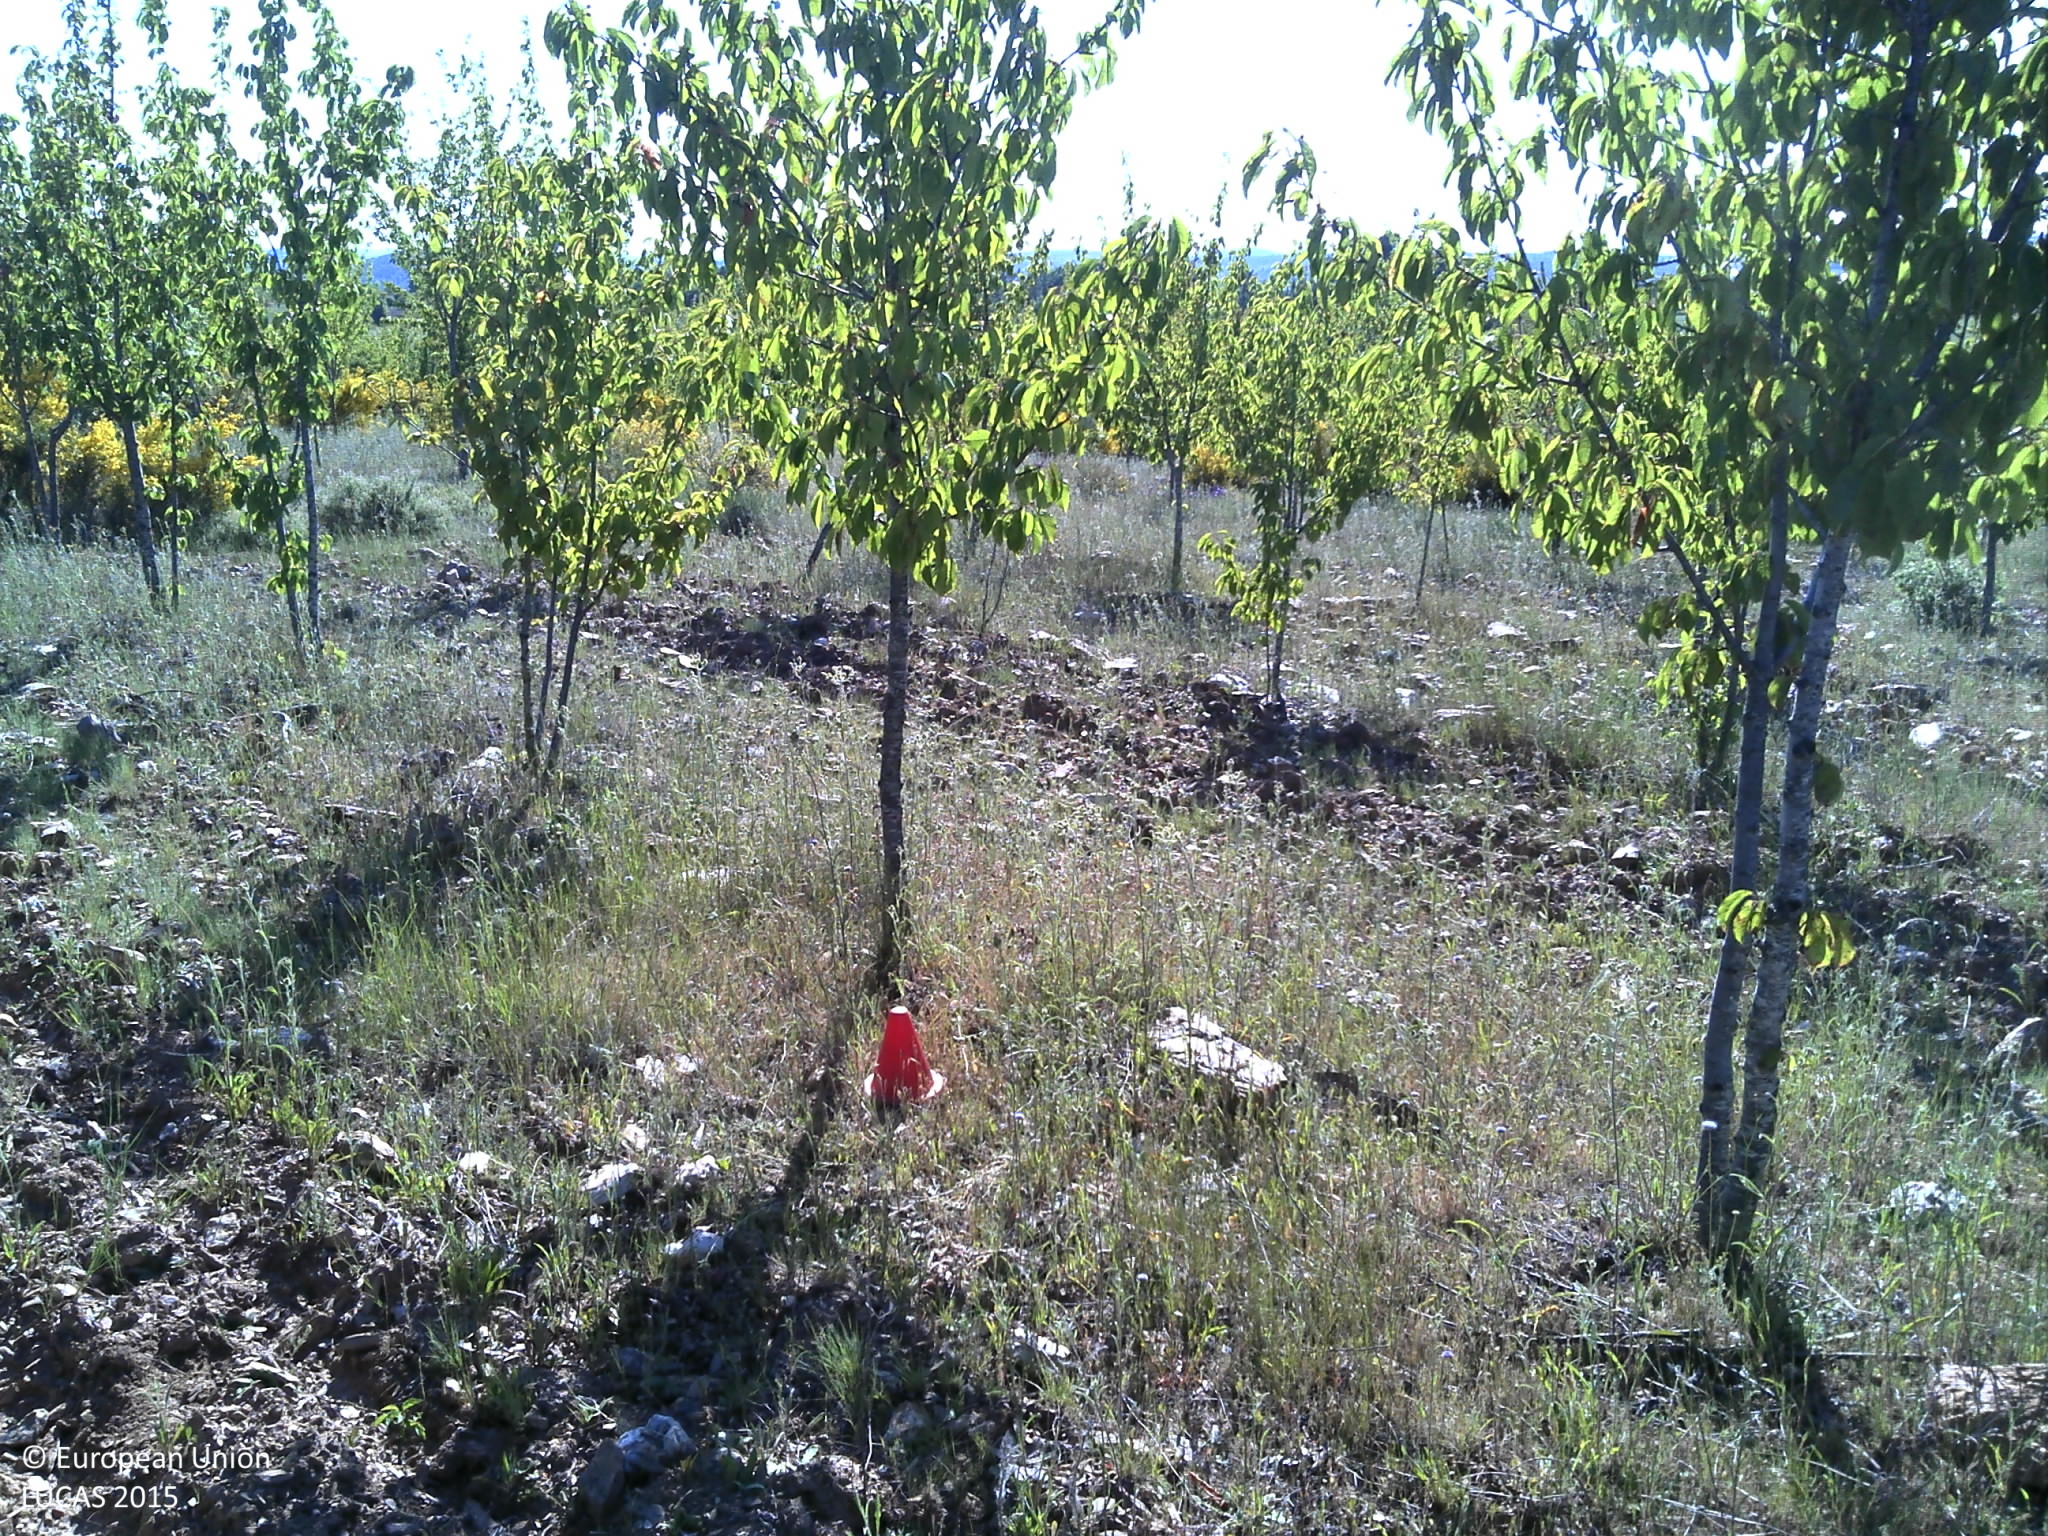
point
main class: Cropland
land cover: Cherry fruit
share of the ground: 25 - 50 %
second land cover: Spontaneously vegetated surfaces
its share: 25 - 50 %
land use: Agriculture (excluding fallow land and kitchen gardens)
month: May
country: PT
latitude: 41.6564
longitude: -6.3981
